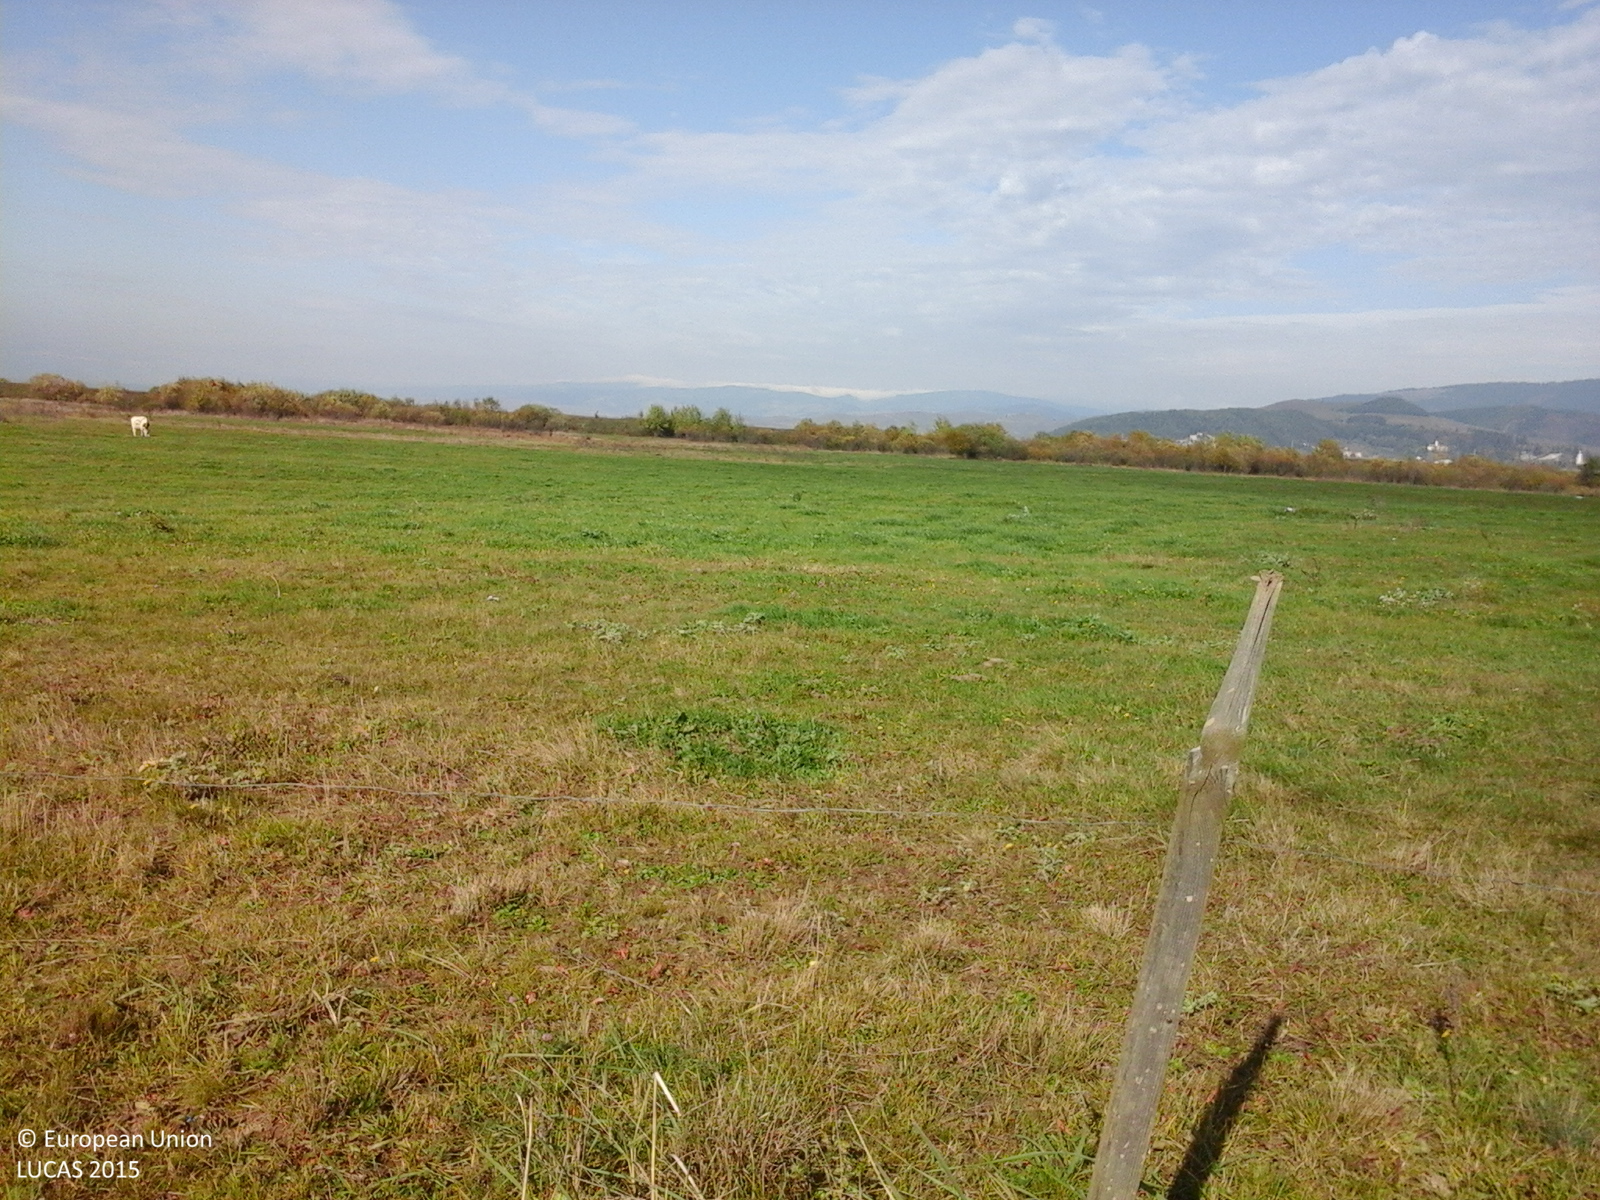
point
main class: Grassland
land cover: Grassland without tree/shrub cover
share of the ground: > 75 %
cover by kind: herbaceous plants 100 %
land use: Agriculture (excluding fallow land and kitchen gardens)
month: October
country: RO
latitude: 46.7143
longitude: 25.5078
